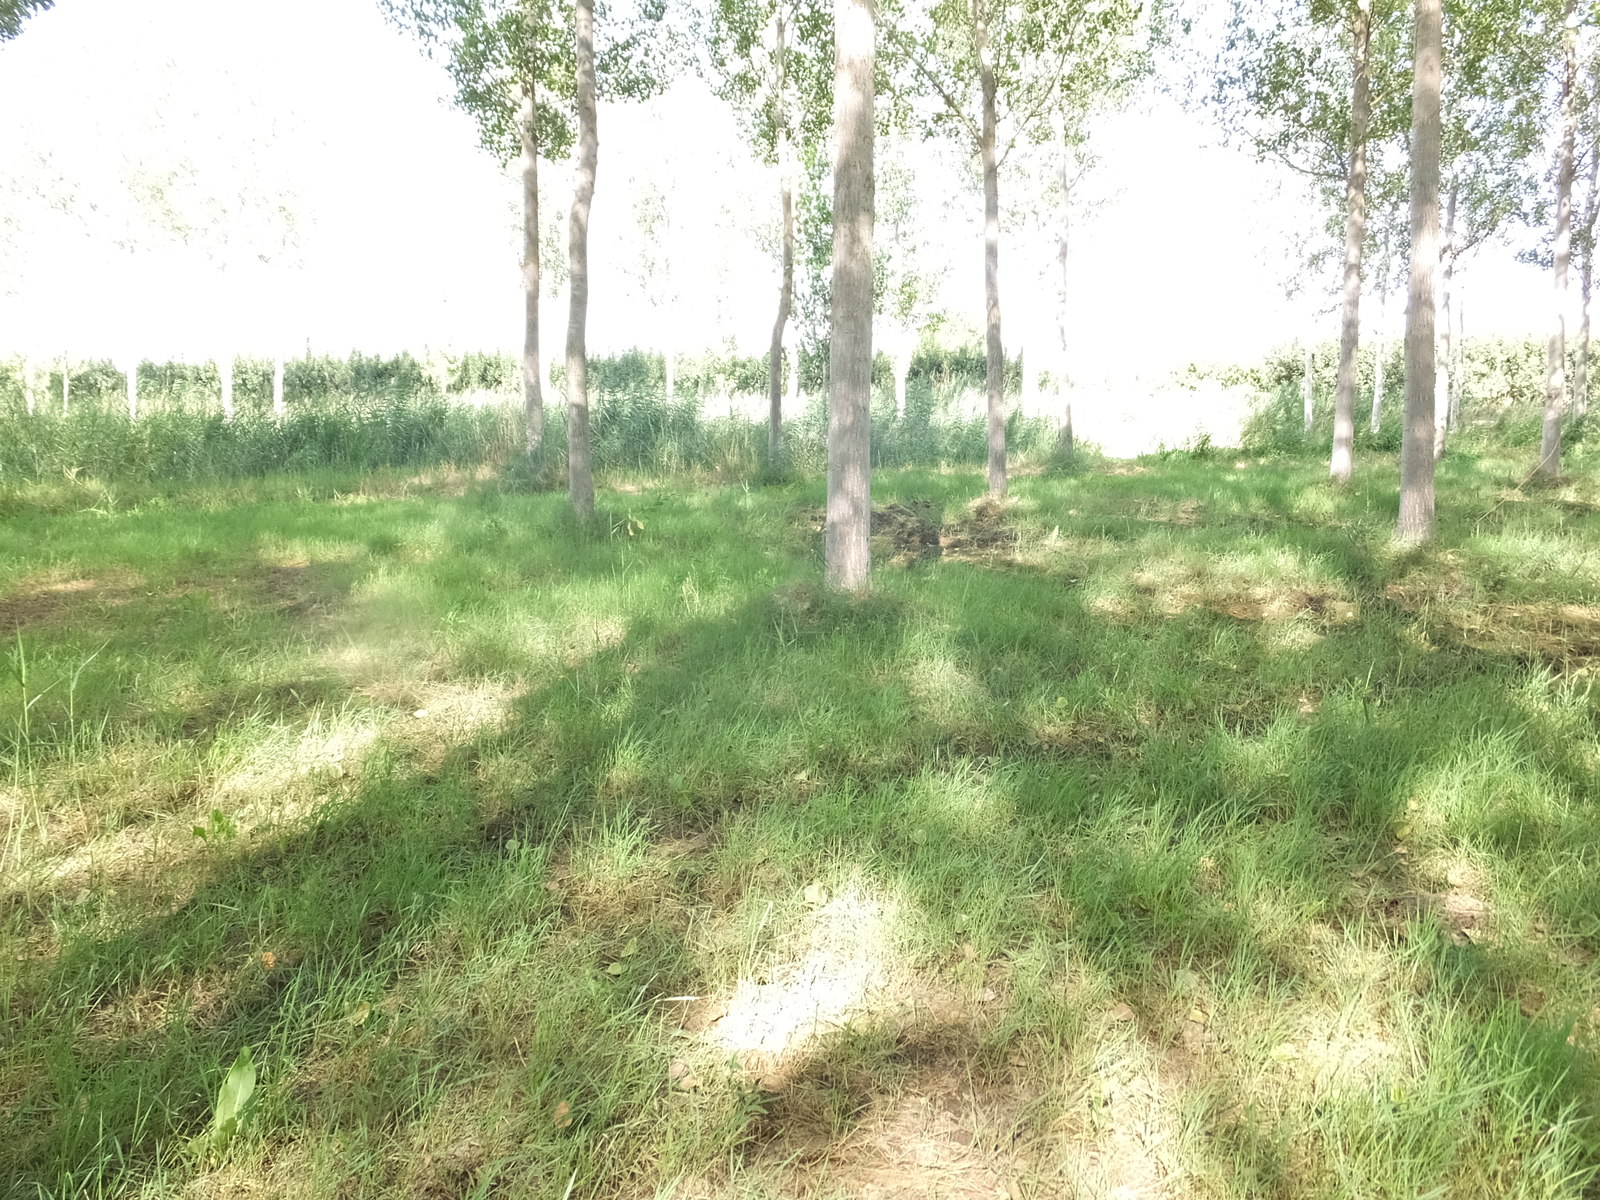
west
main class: Woodland
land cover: Broadleaved woodland
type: broadleaved evergreen forest
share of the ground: > 75 %
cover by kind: broadleaved forest trees 95 %, herbaceous plants 5 %
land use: Forestry
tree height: > 5 m
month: July
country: ES
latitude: 41.4741
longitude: 0.4441
